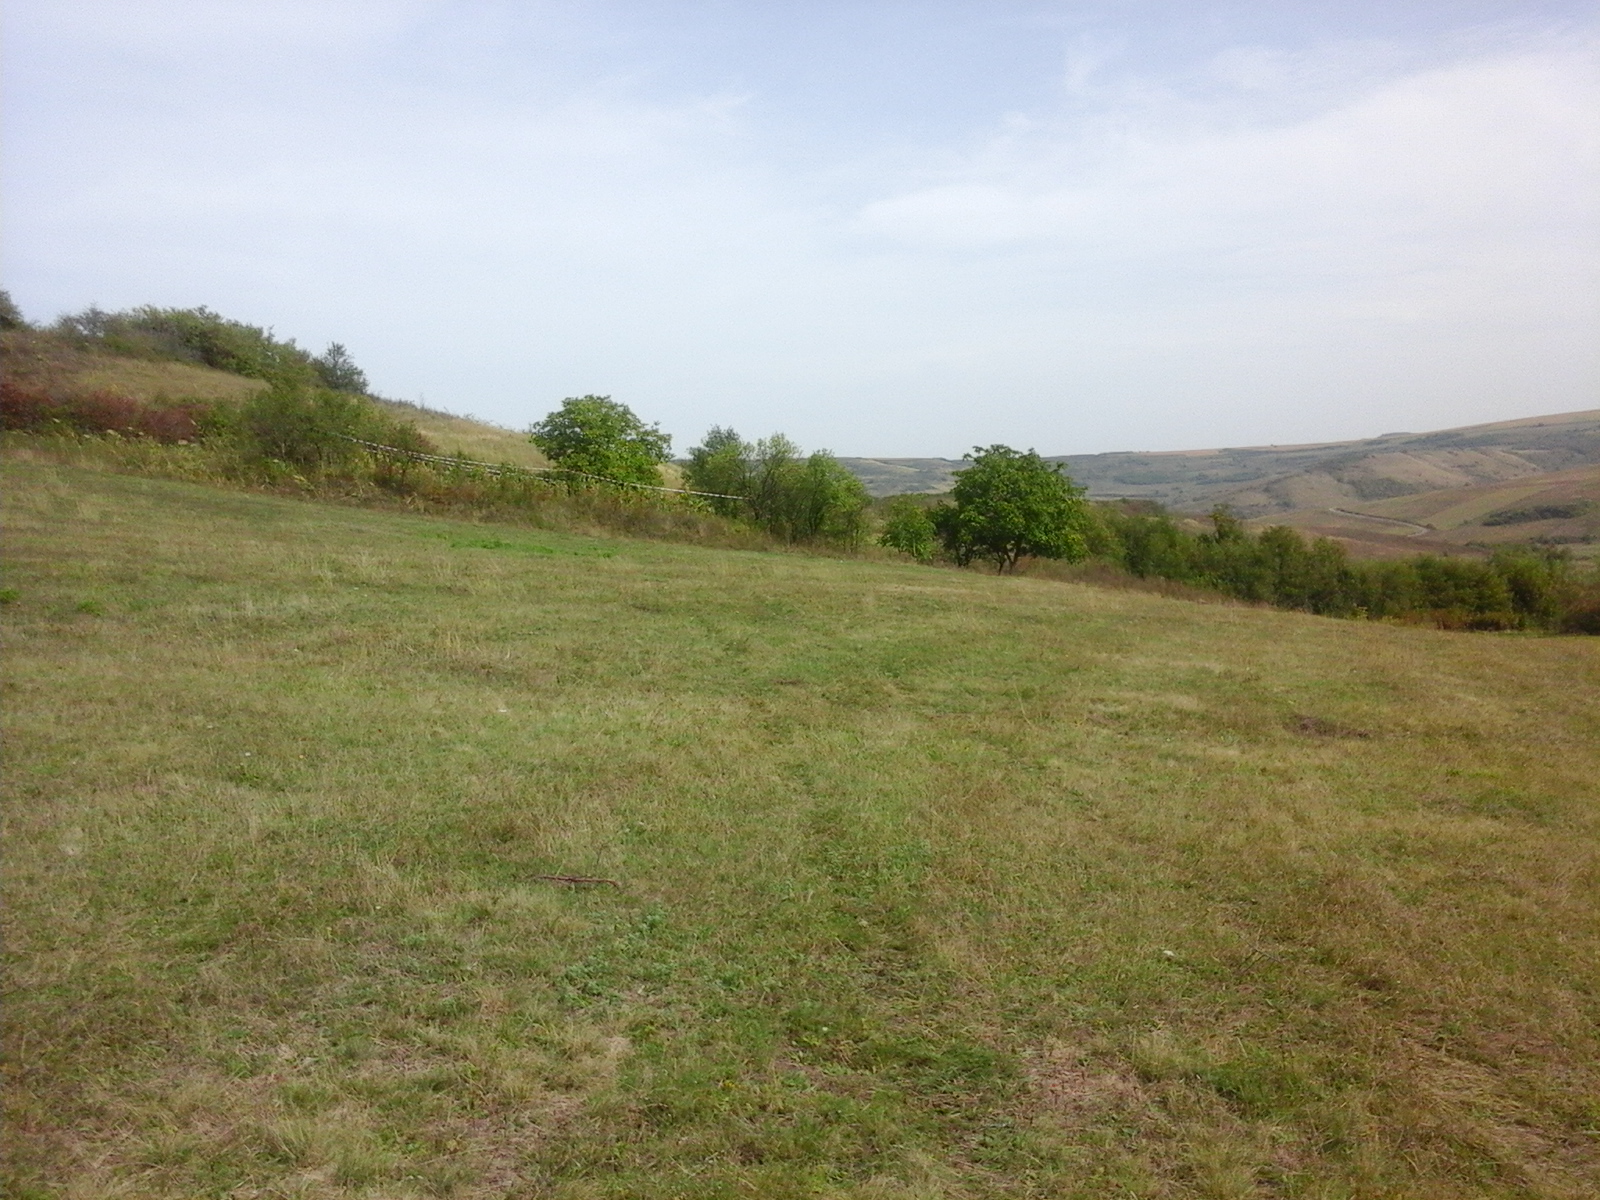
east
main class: Grassland
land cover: Grassland without tree/shrub cover
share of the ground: > 75 %
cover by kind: herbaceous plants 100 %
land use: Agriculture (excluding fallow land and kitchen gardens)
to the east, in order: Grassland without tree/shrub cover; Shrubland without tree cover; Artificial constructions in urban areas; Permanent crops (only in case pi); Shrubland without tree cover
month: September
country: RO
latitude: 46.9144
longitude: 24.0645
